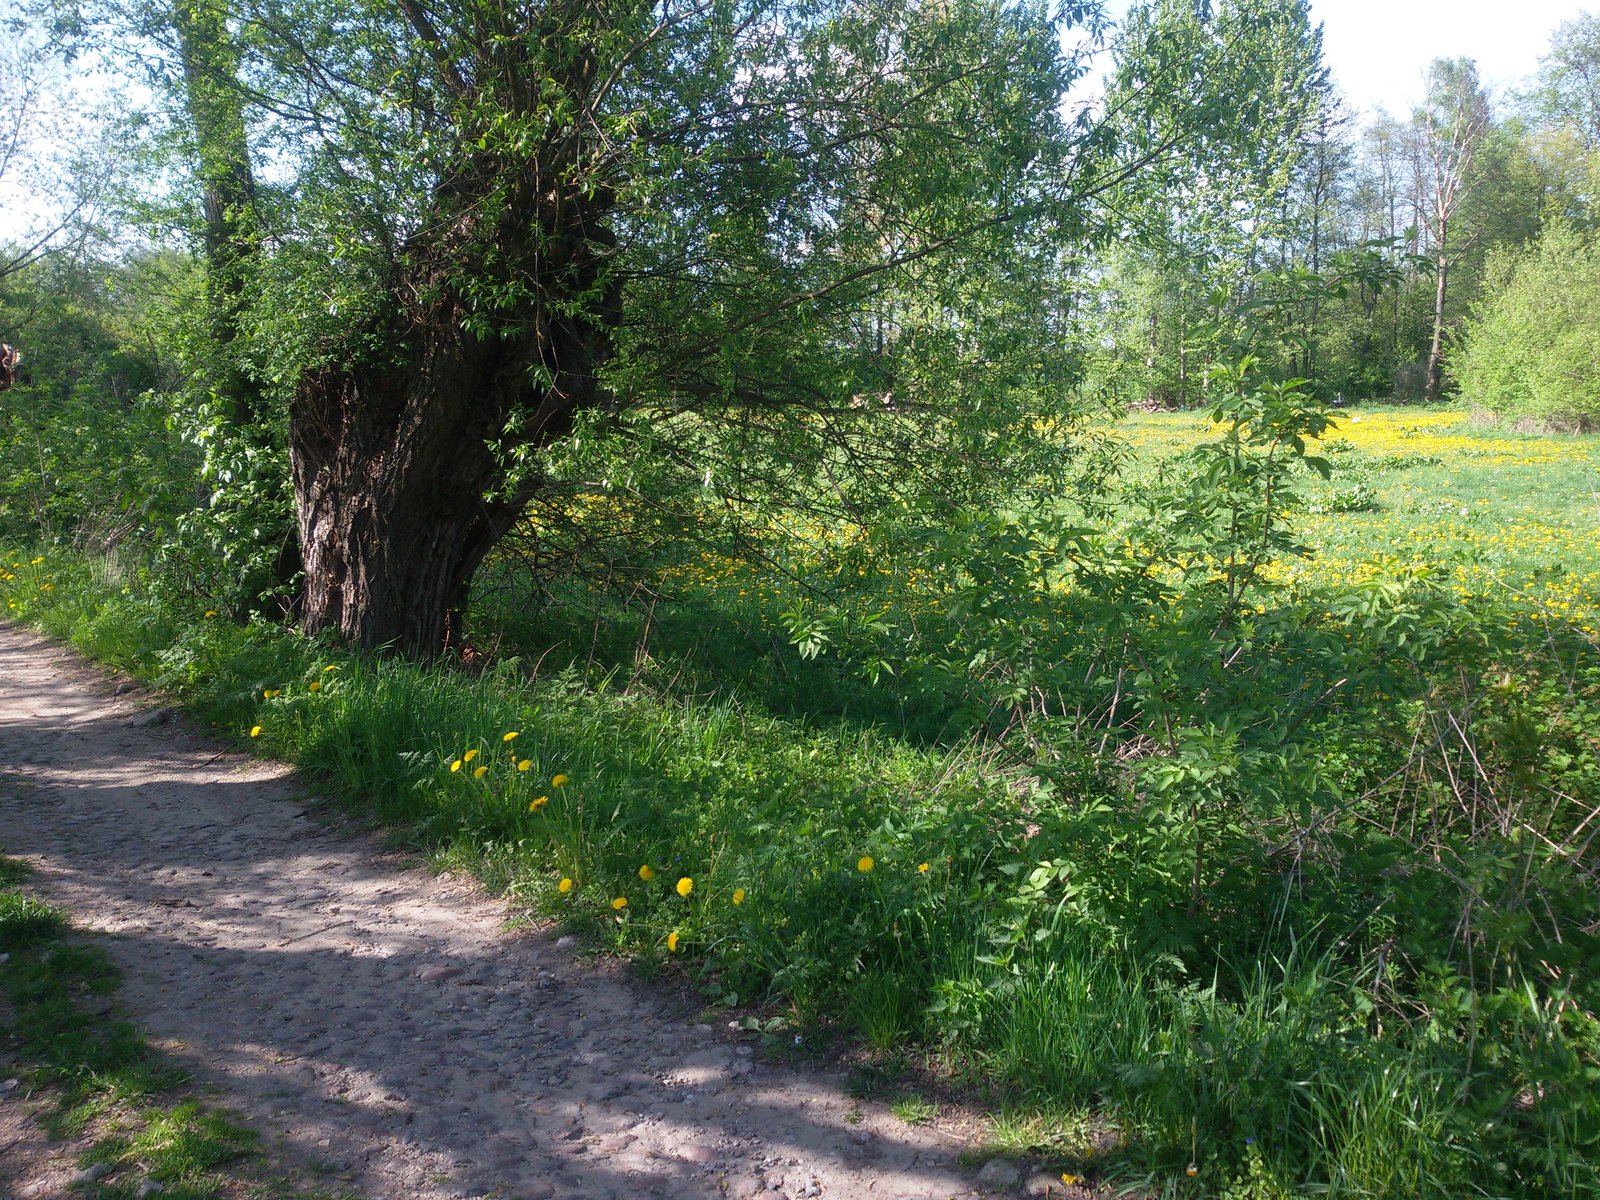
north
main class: Grassland
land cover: Grassland without tree/shrub cover
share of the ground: > 75 %
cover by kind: herbaceous plants 100 %
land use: Agriculture (excluding fallow land and kitchen gardens)
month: May
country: PL
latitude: 52.8051
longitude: 22.3309
